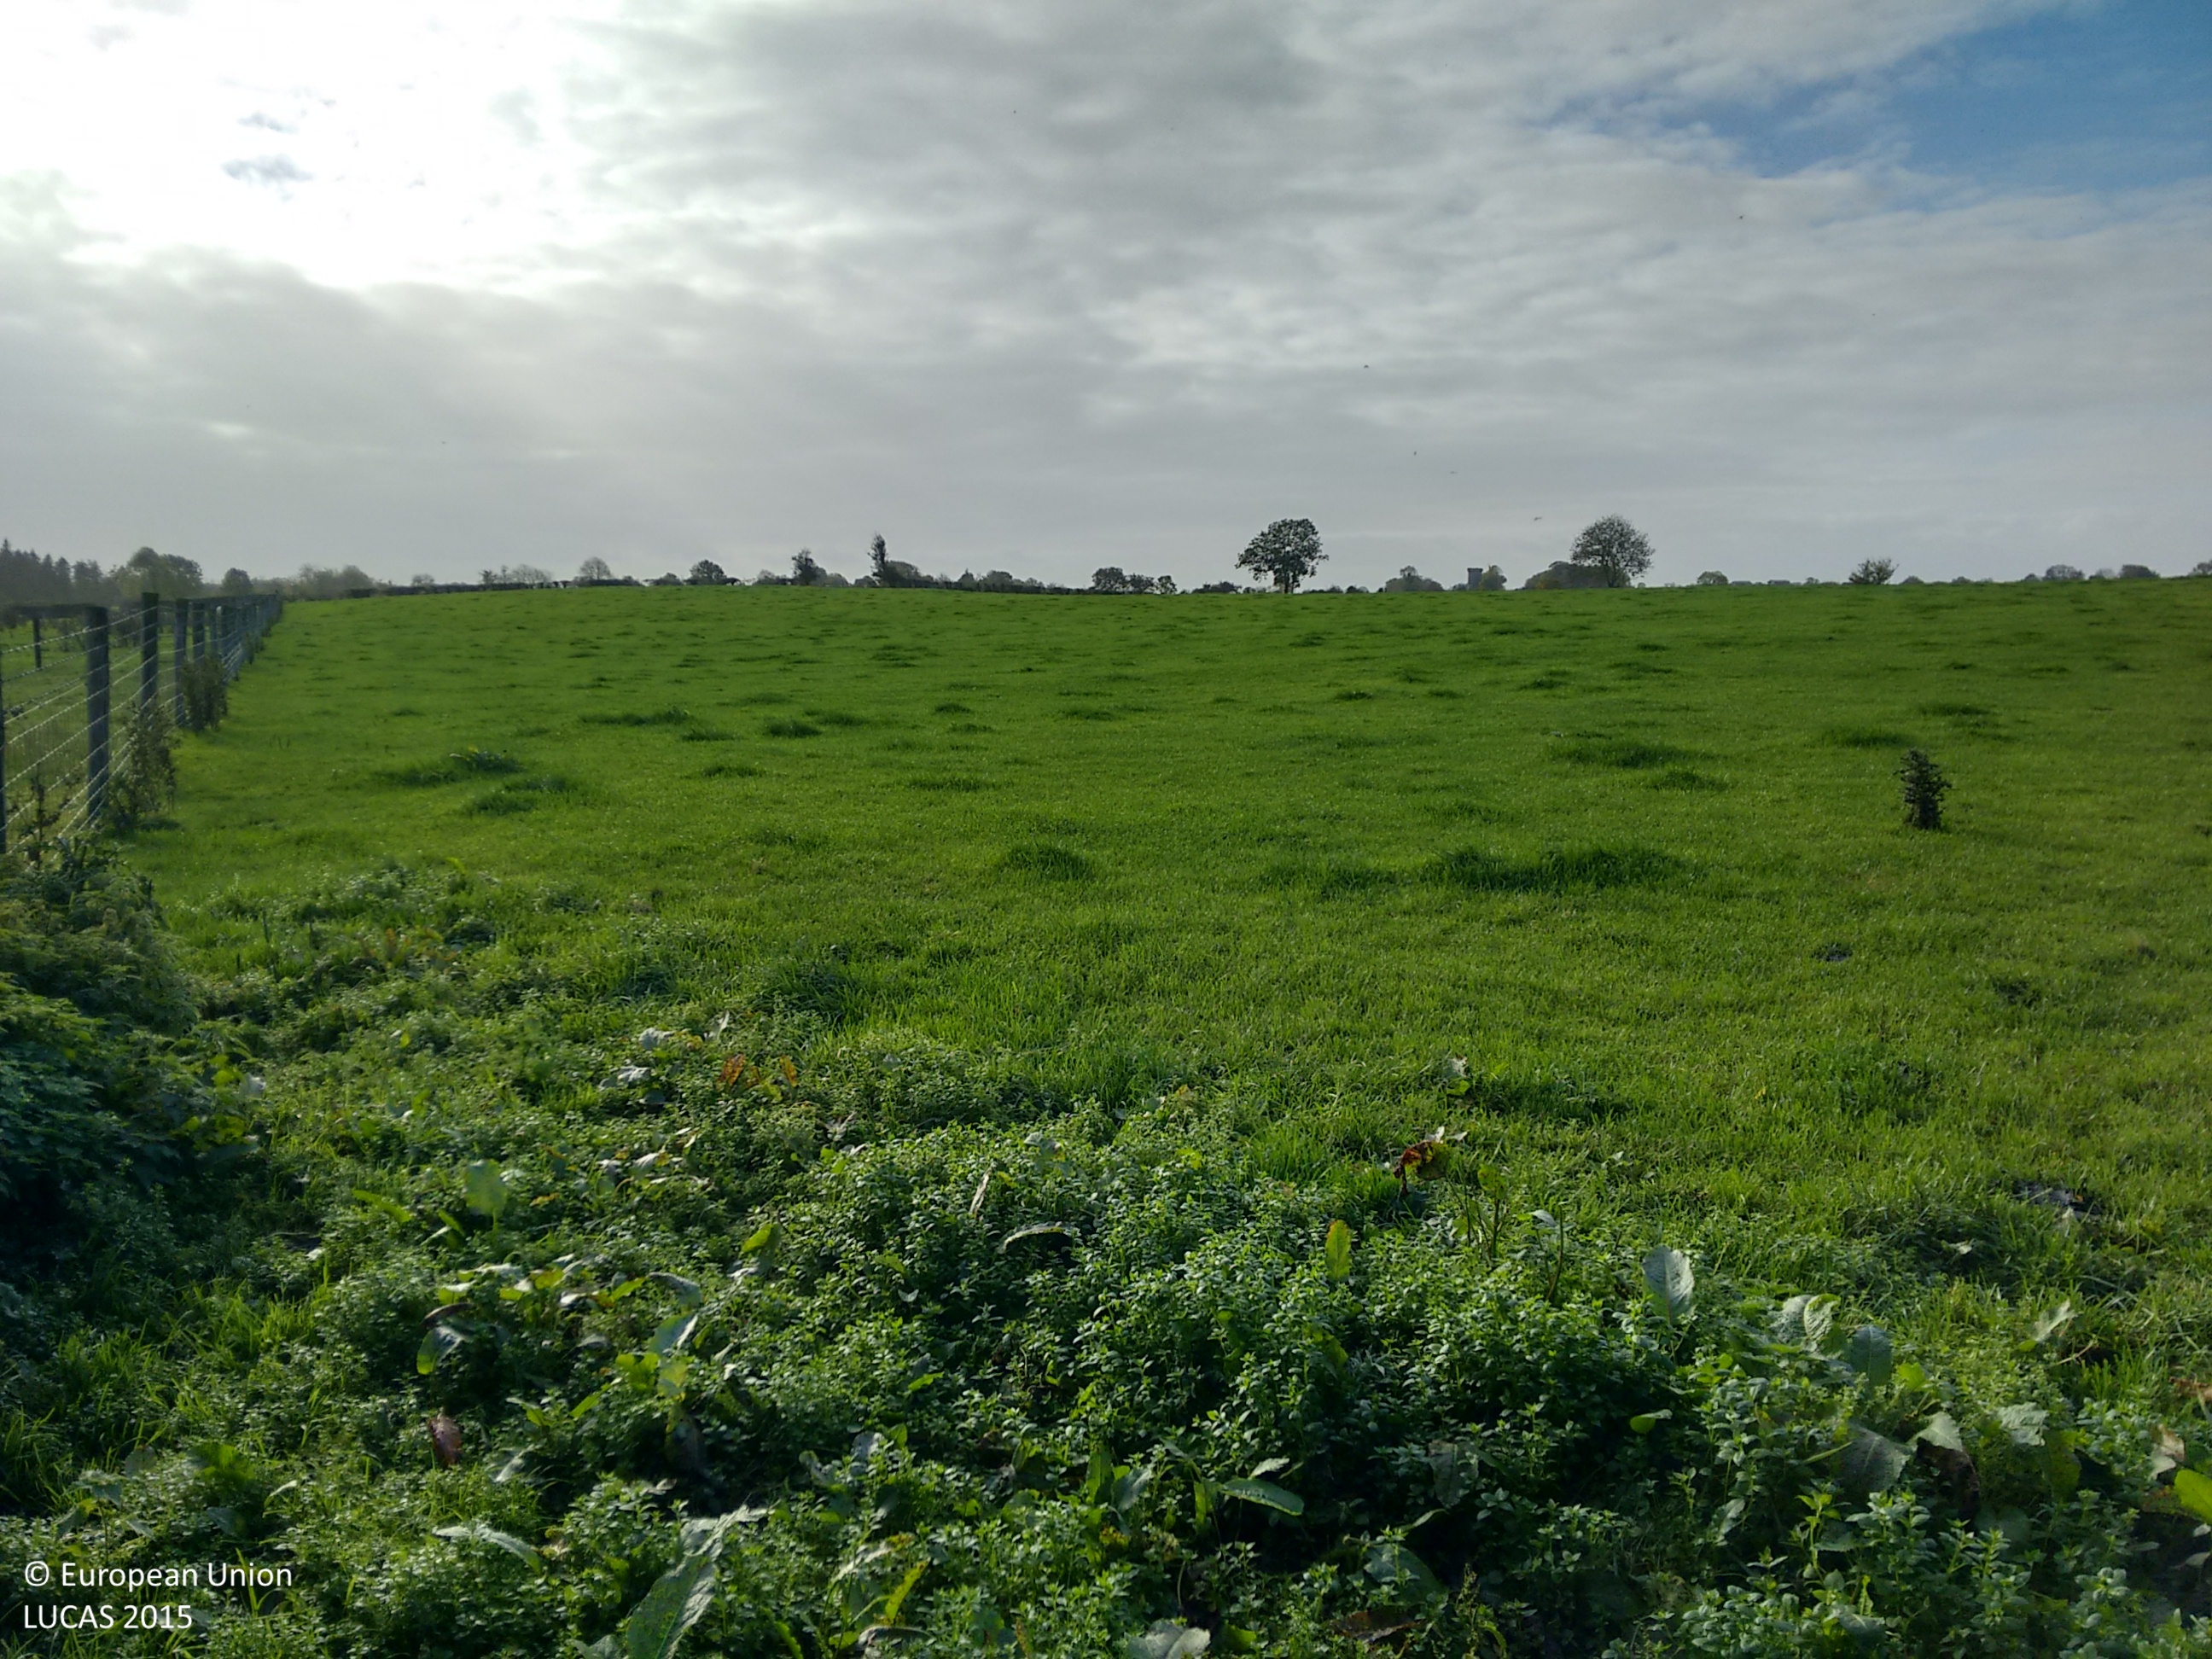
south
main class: Grassland
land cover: Grassland without tree/shrub cover
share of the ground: > 75 %
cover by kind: herbaceous plants 100 %
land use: Agriculture (excluding fallow land and kitchen gardens)
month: October
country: IE
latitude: 52.7951
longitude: -7.8638
